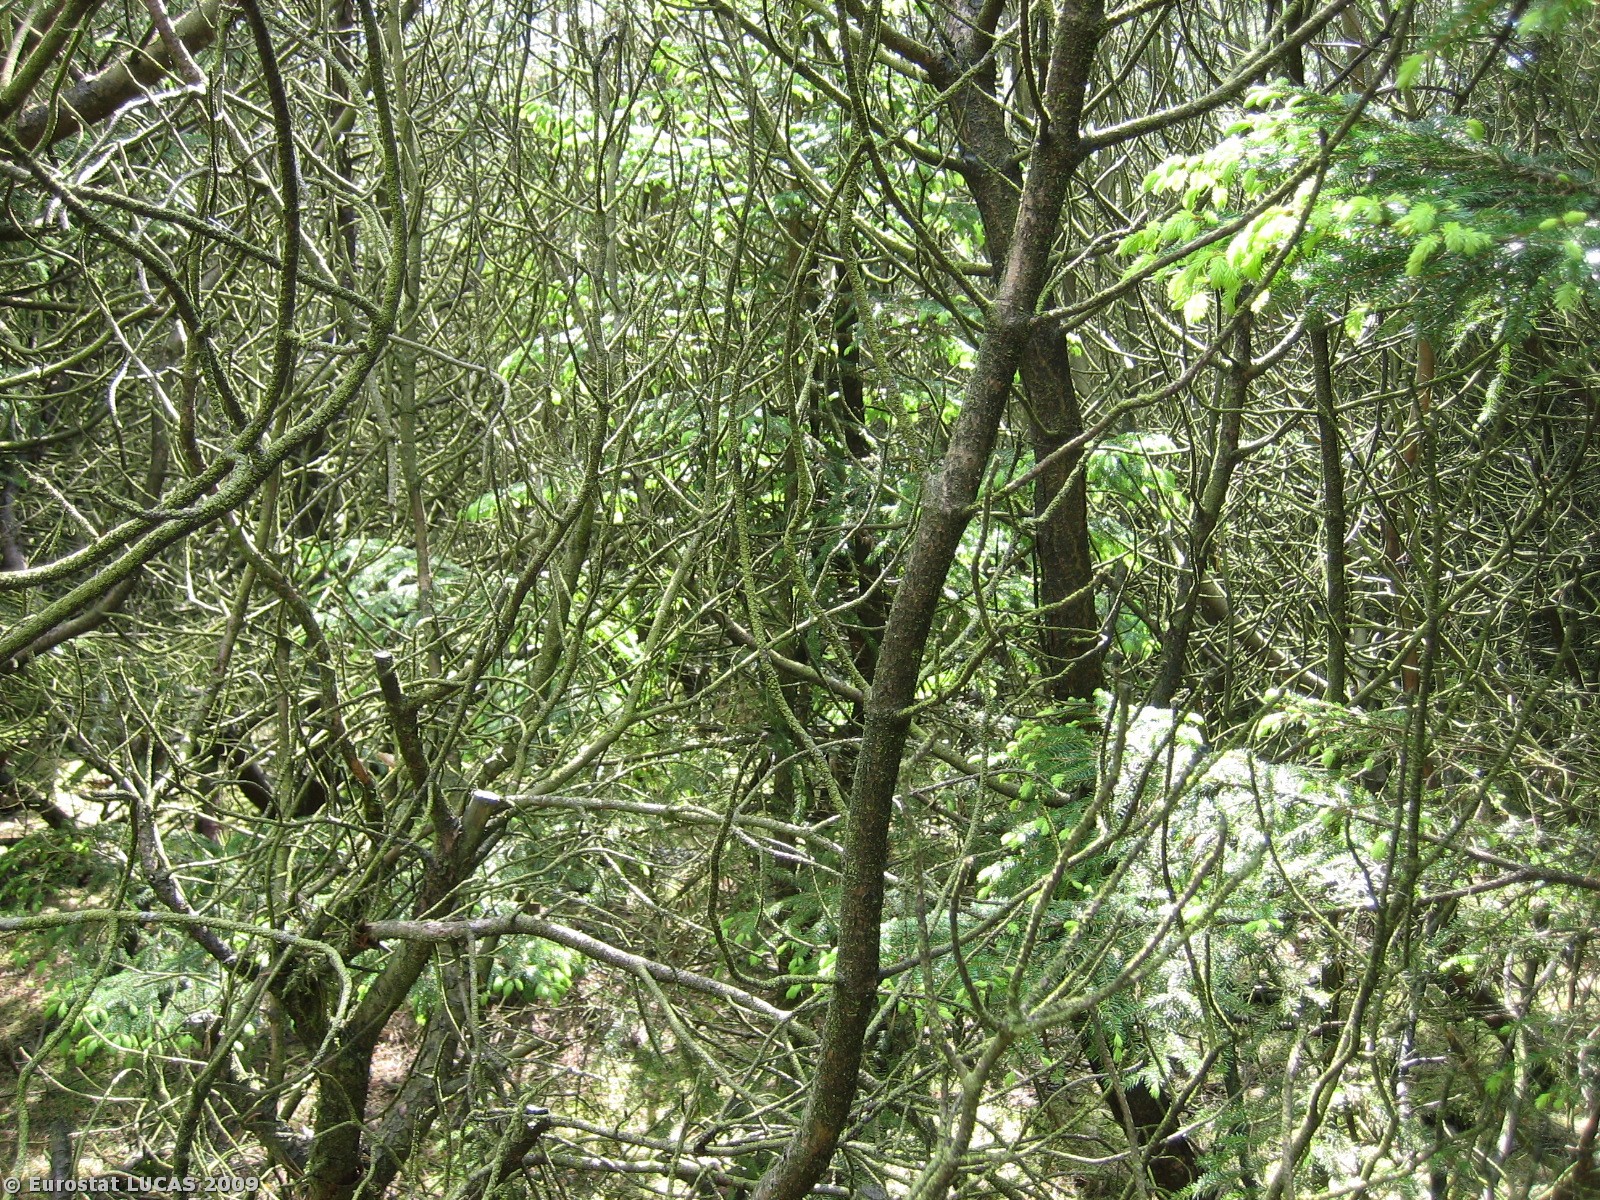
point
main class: Woodland
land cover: Coniferous woodland
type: hemiboreal forest and nemoral coniferous forest and mixed broadleaved-coniferous forest
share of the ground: > 75 %
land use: Forestry
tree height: > 5 m
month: May
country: DK
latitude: 56.2546
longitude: 8.8553
